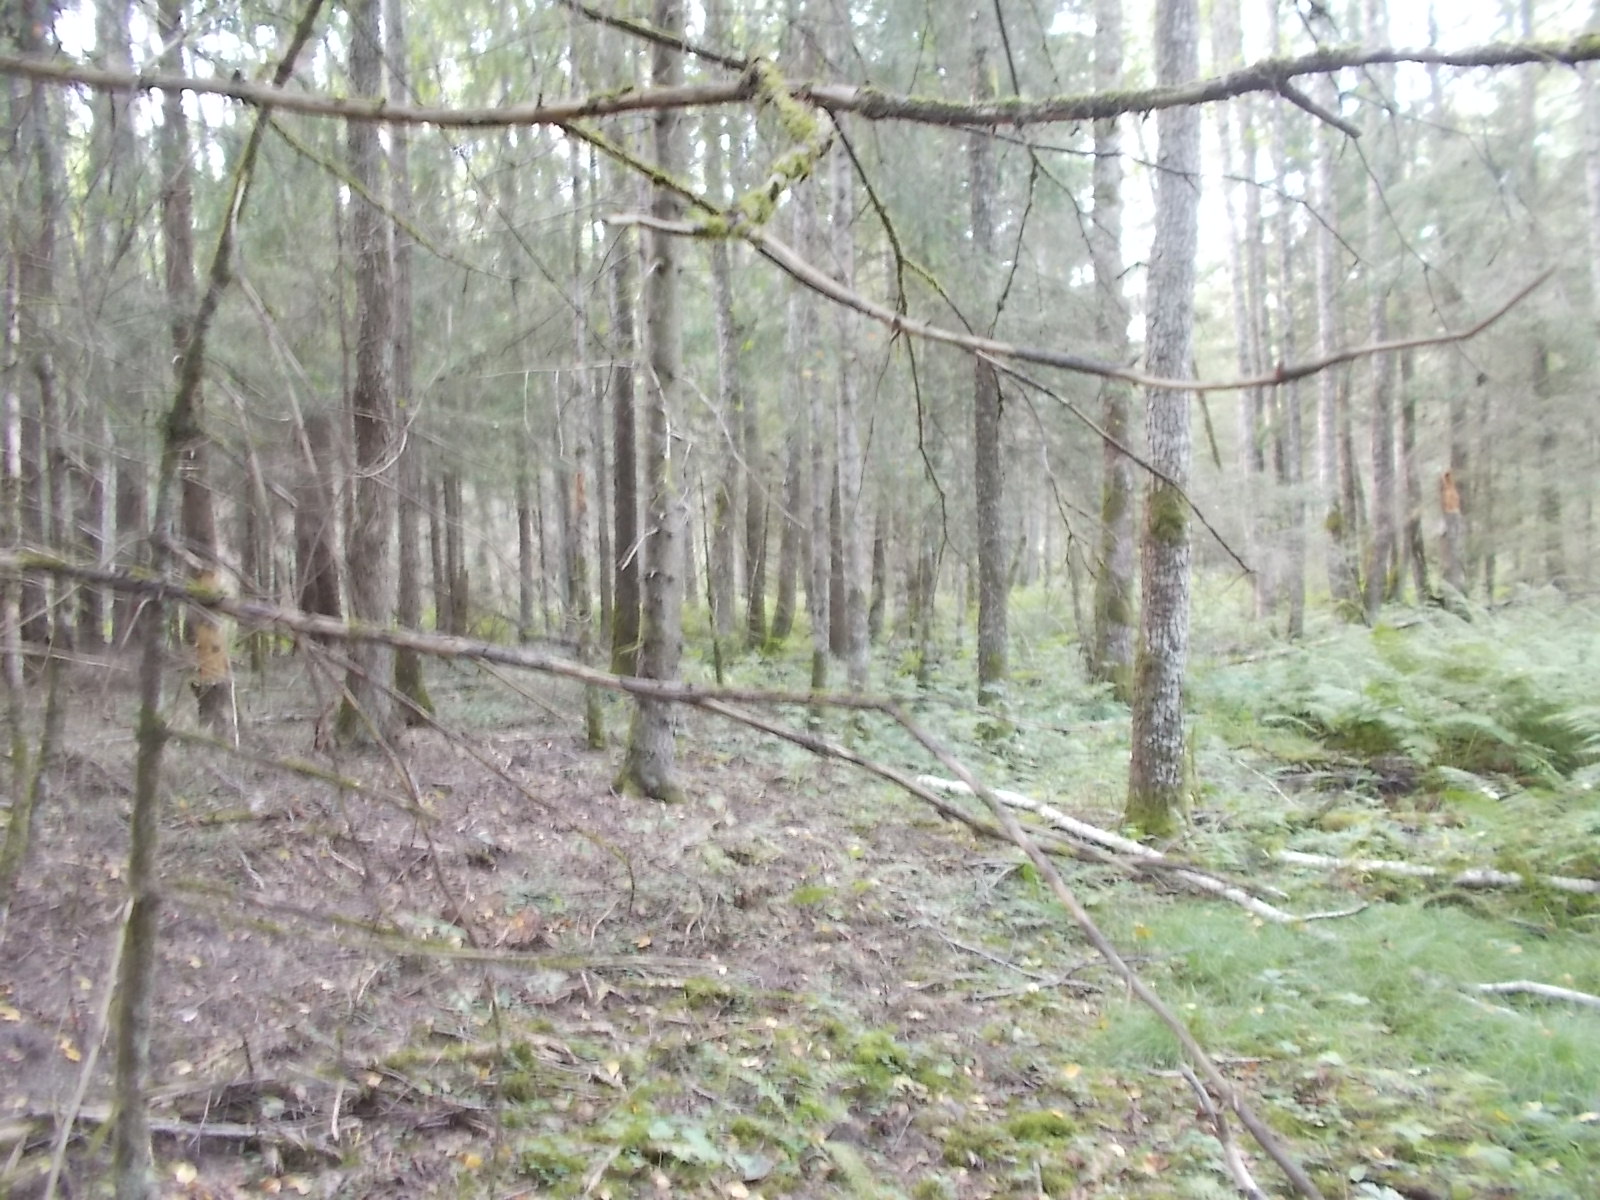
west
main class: Woodland
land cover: Spruce dominated mixed woodland
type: hemiboreal forest and nemoral coniferous forest and mixed broadleaved-coniferous forest
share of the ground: 50 - 75 %
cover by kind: coniferous forest trees 35 %, broadleaved forest trees 35 %, herbaceous plants 15 %, unconsolidated bare surface 10 %, shrubs 5 %
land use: Forestry
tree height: > 5 m
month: September
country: LV
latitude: 57.1311
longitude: 21.8235
